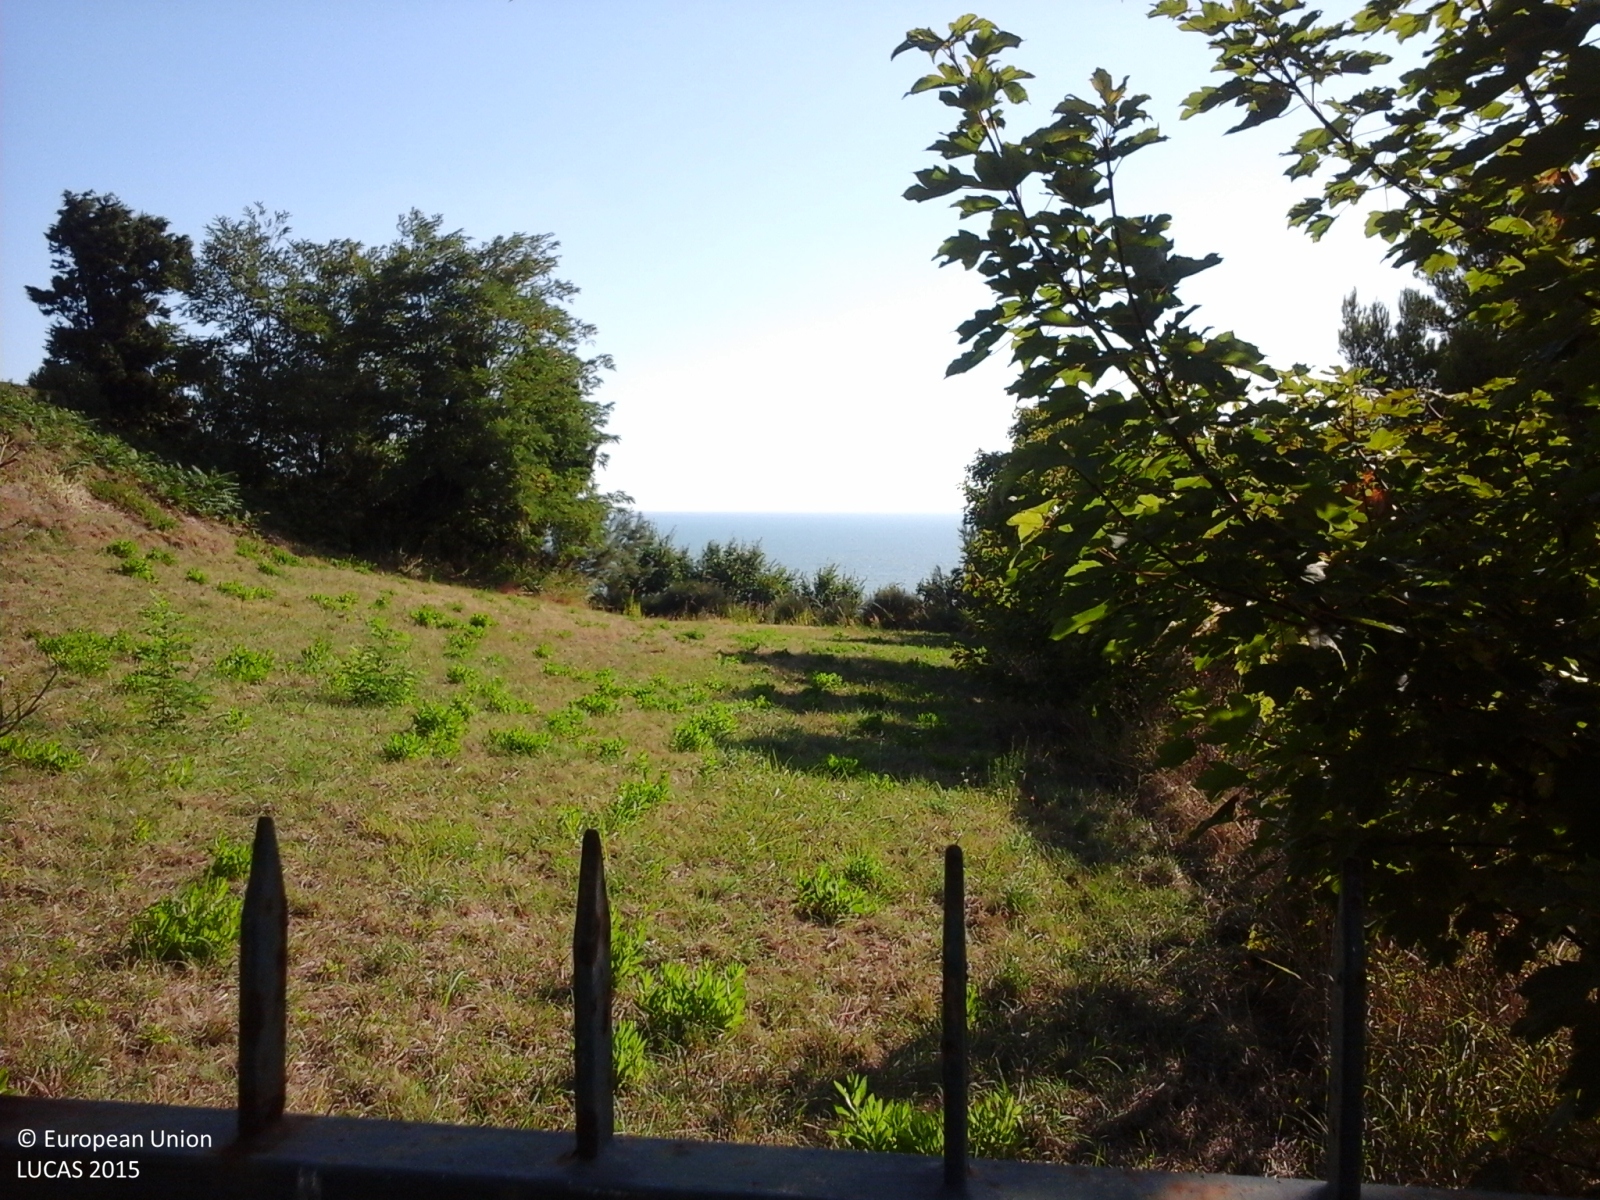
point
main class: Woodland
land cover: Broadleaved woodland
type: thermophilous deciduous forest
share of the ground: > 75 %
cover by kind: broadleaved forest trees 100 %
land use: Forestry
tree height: > 5 m
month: September
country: IT
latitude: 43.8937
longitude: 12.9436
